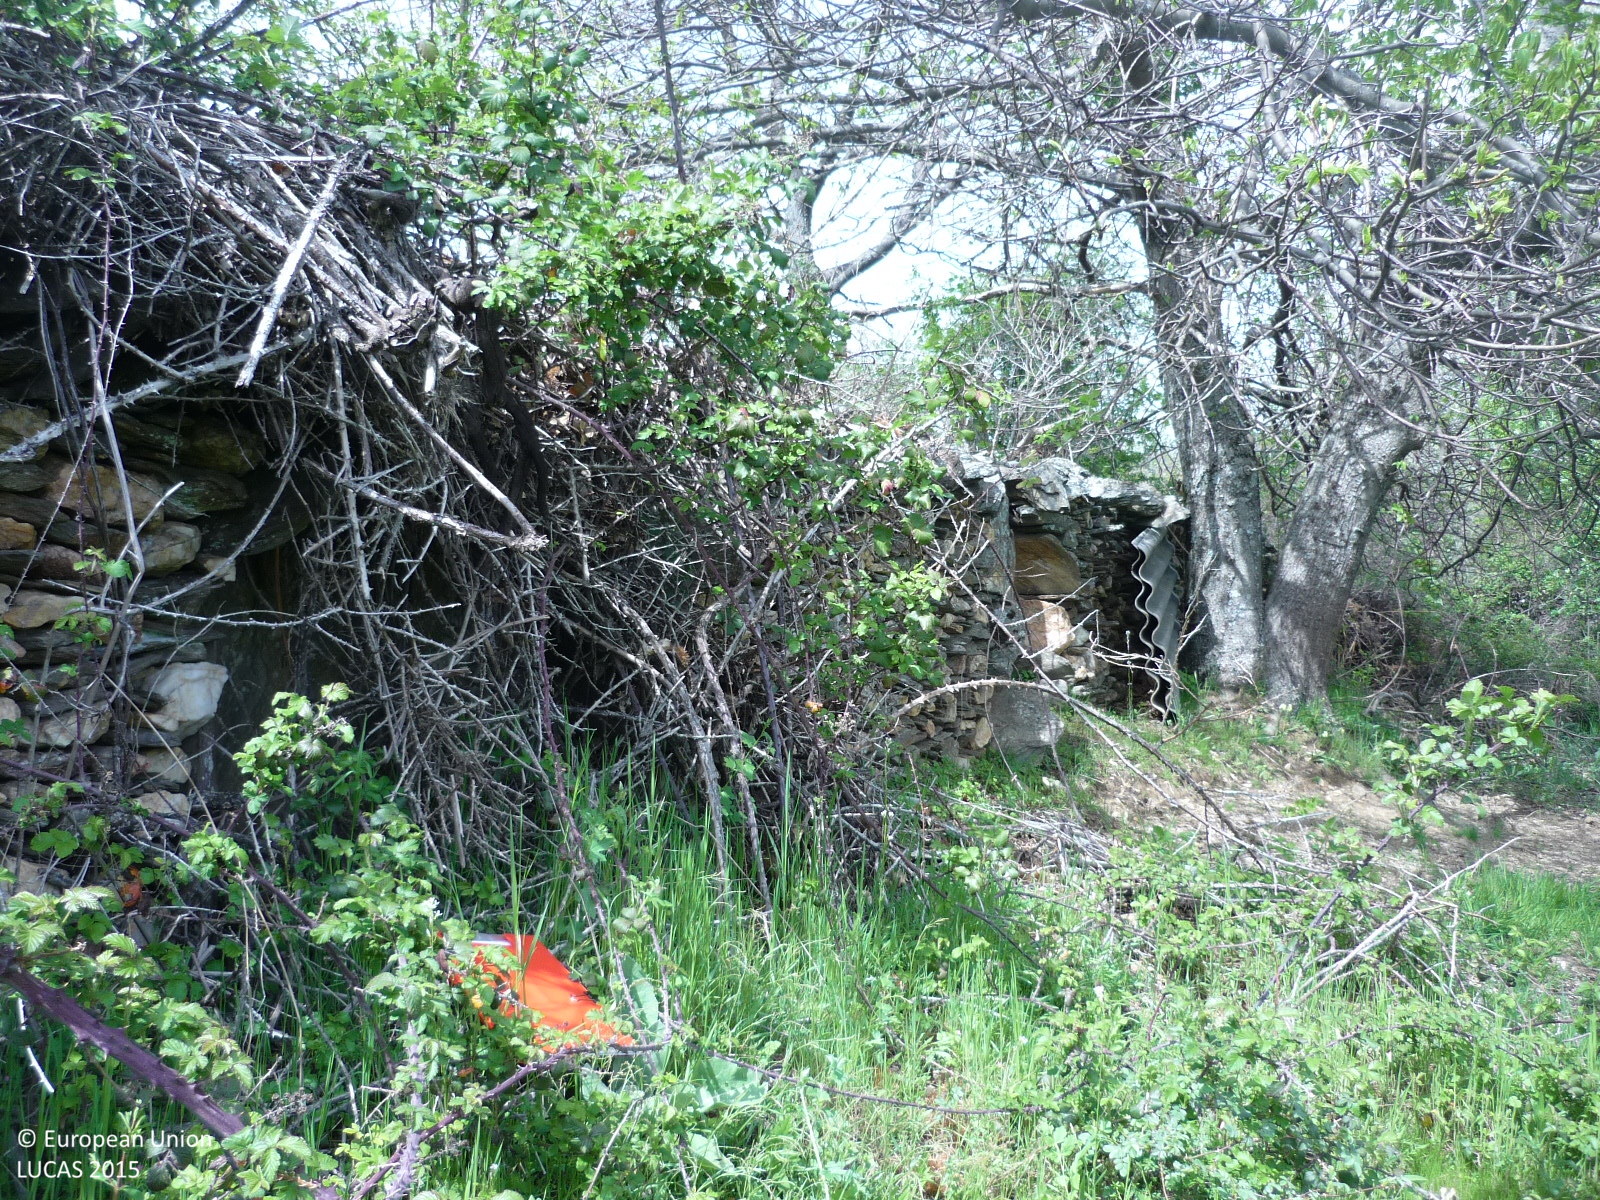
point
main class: Shrubland
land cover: Shrubland with sparse tree cover
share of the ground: > 75 %
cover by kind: shrubs 85 %, herbaceous plants 10 %, broadleaved forest trees 5 %
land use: Semi-natural and natural areas not in use
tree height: < 5 m
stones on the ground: < 10 %
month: May
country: ES
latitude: 41.0862
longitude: -3.5067
